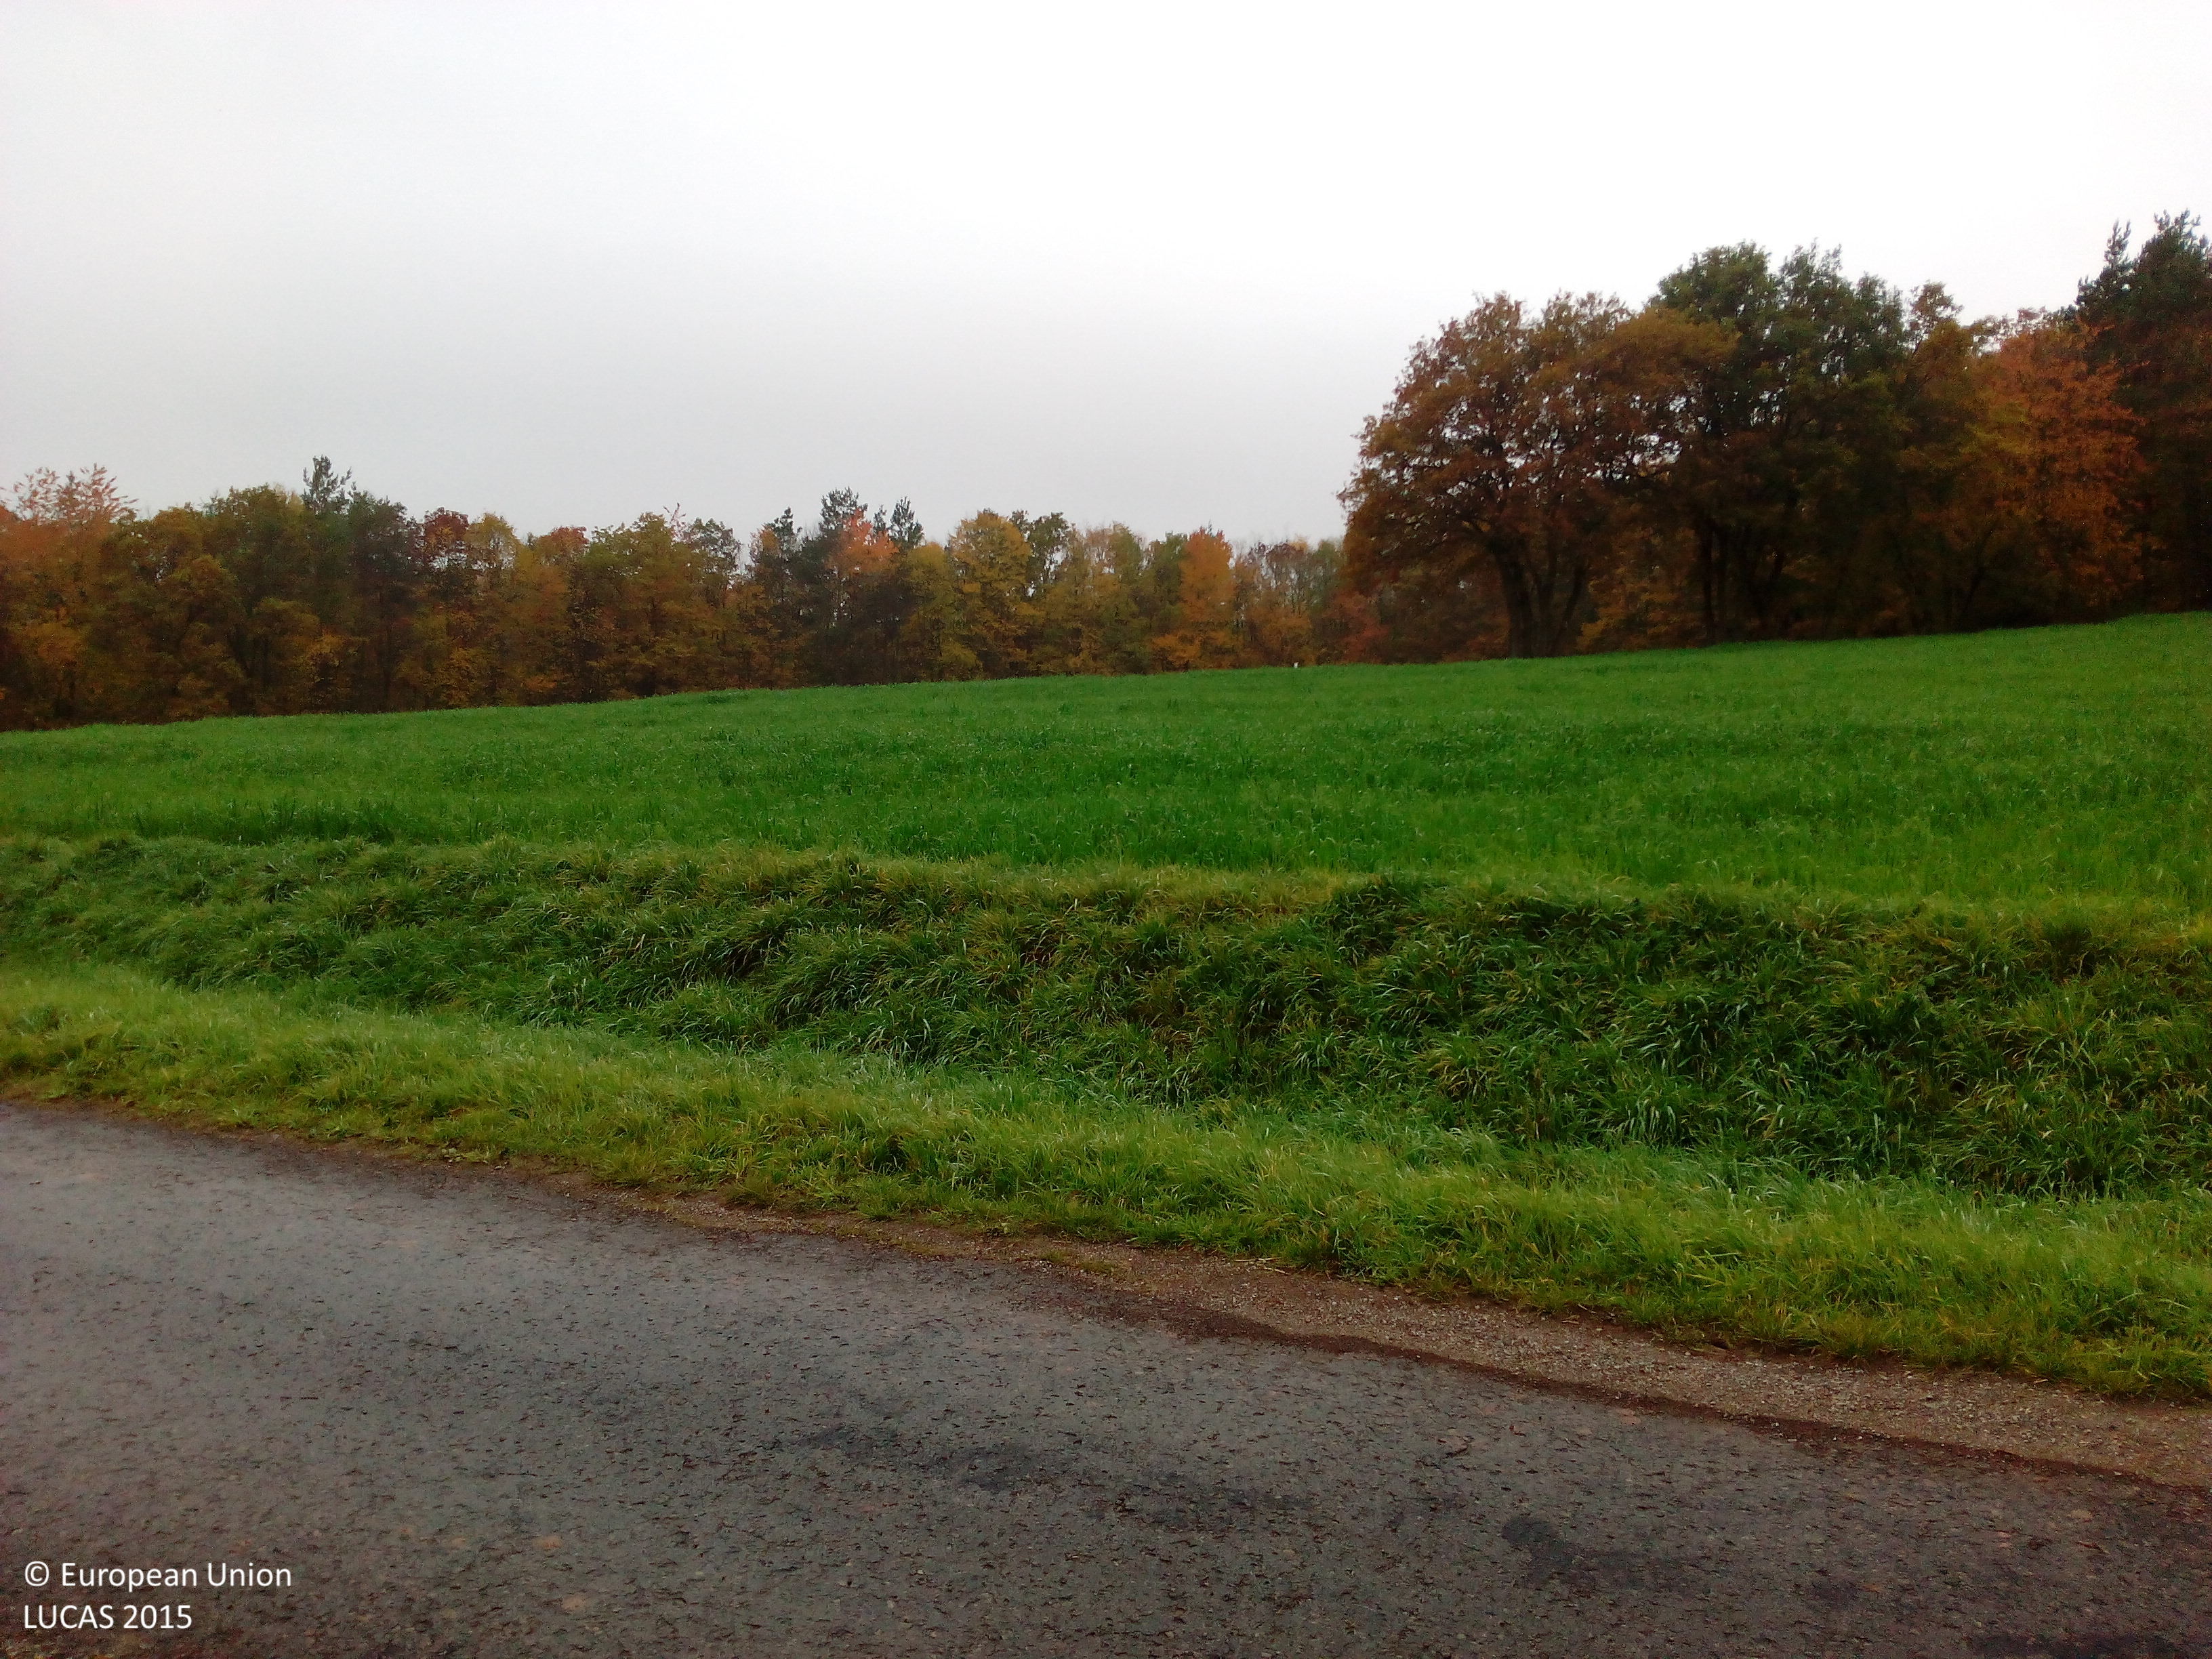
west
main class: Cropland
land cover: Common wheat
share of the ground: < 10 %
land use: Agriculture (excluding fallow land and kitchen gardens)
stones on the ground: 10 - 25 %
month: October
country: DE
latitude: 50.1662
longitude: 9.9020
